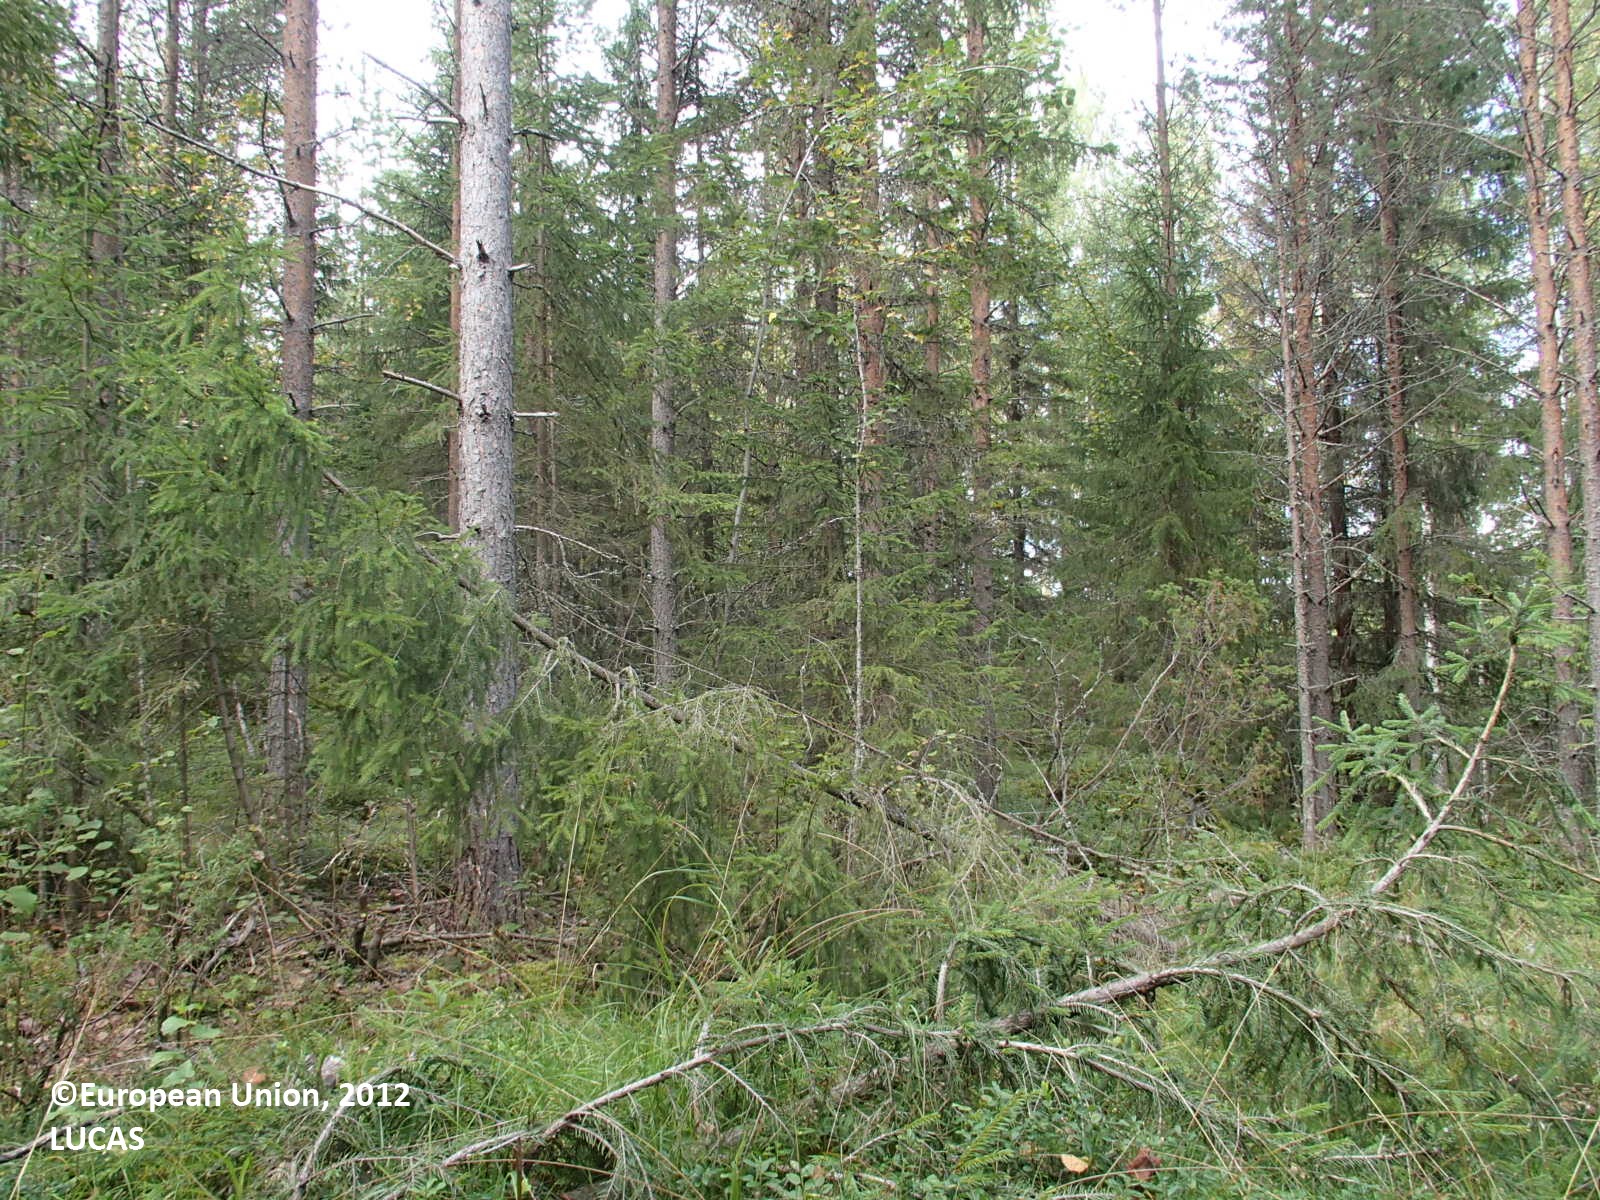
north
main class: Woodland
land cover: Other coniferous woodland
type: boreal forest
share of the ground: > 75 %
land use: Forestry
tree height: > 5 m
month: August
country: FI
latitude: 63.6640
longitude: 27.0924
